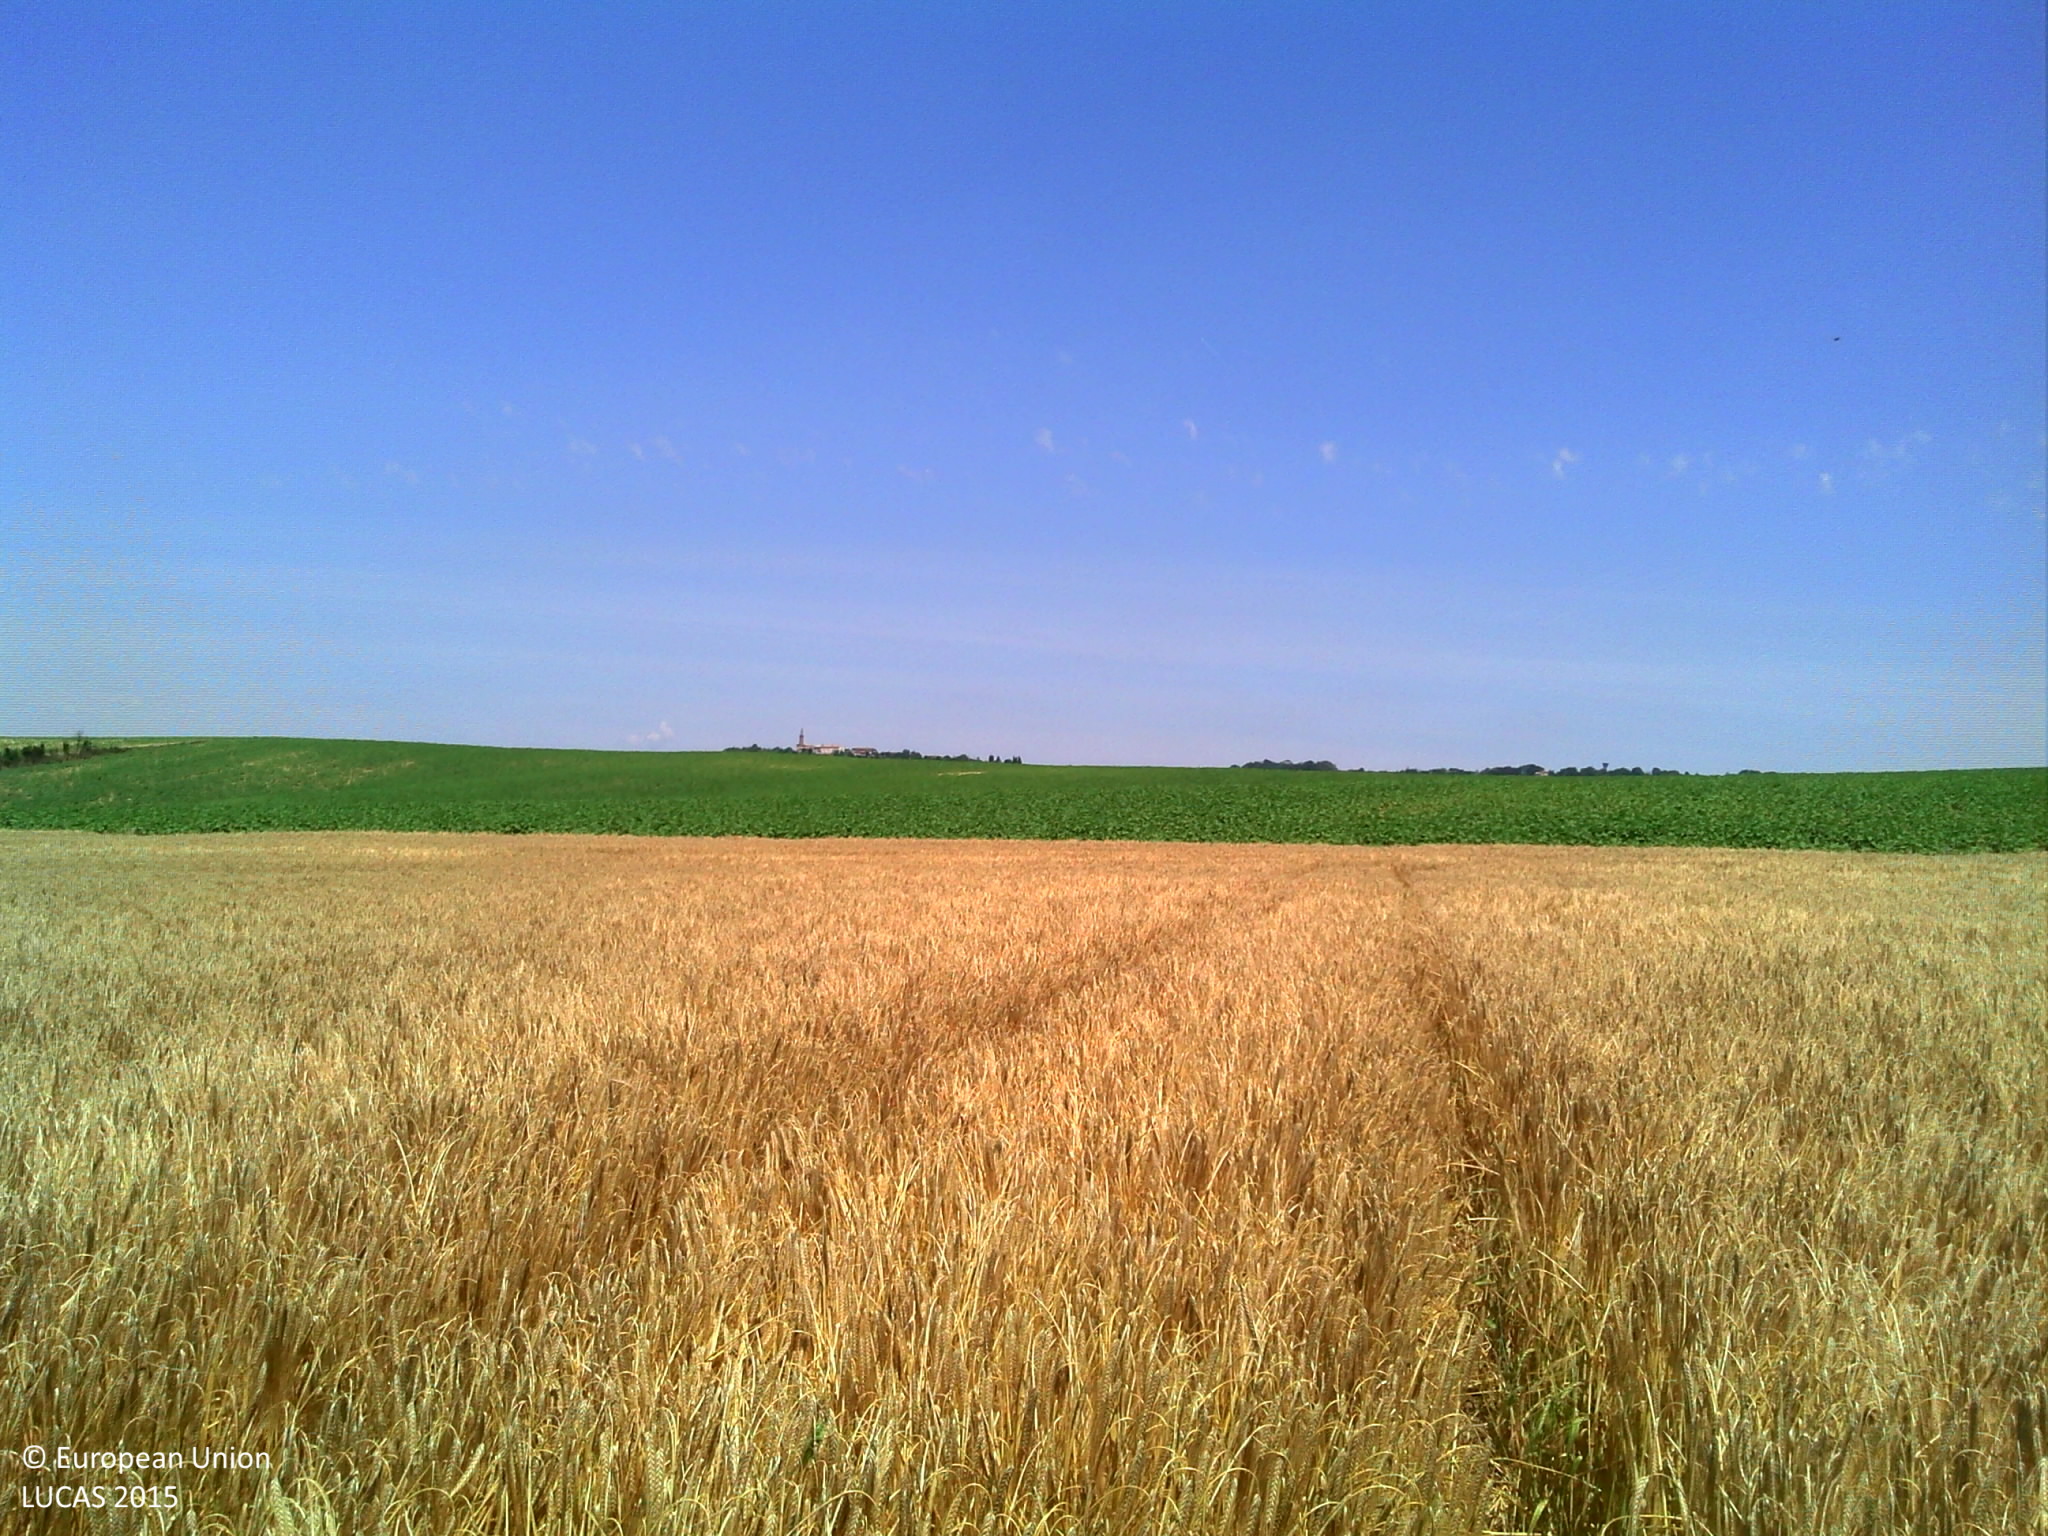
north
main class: Cropland
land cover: Barley
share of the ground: > 75 %
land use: Agriculture (excluding fallow land and kitchen gardens)
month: June
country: FR
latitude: 43.7588
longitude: 0.9945
